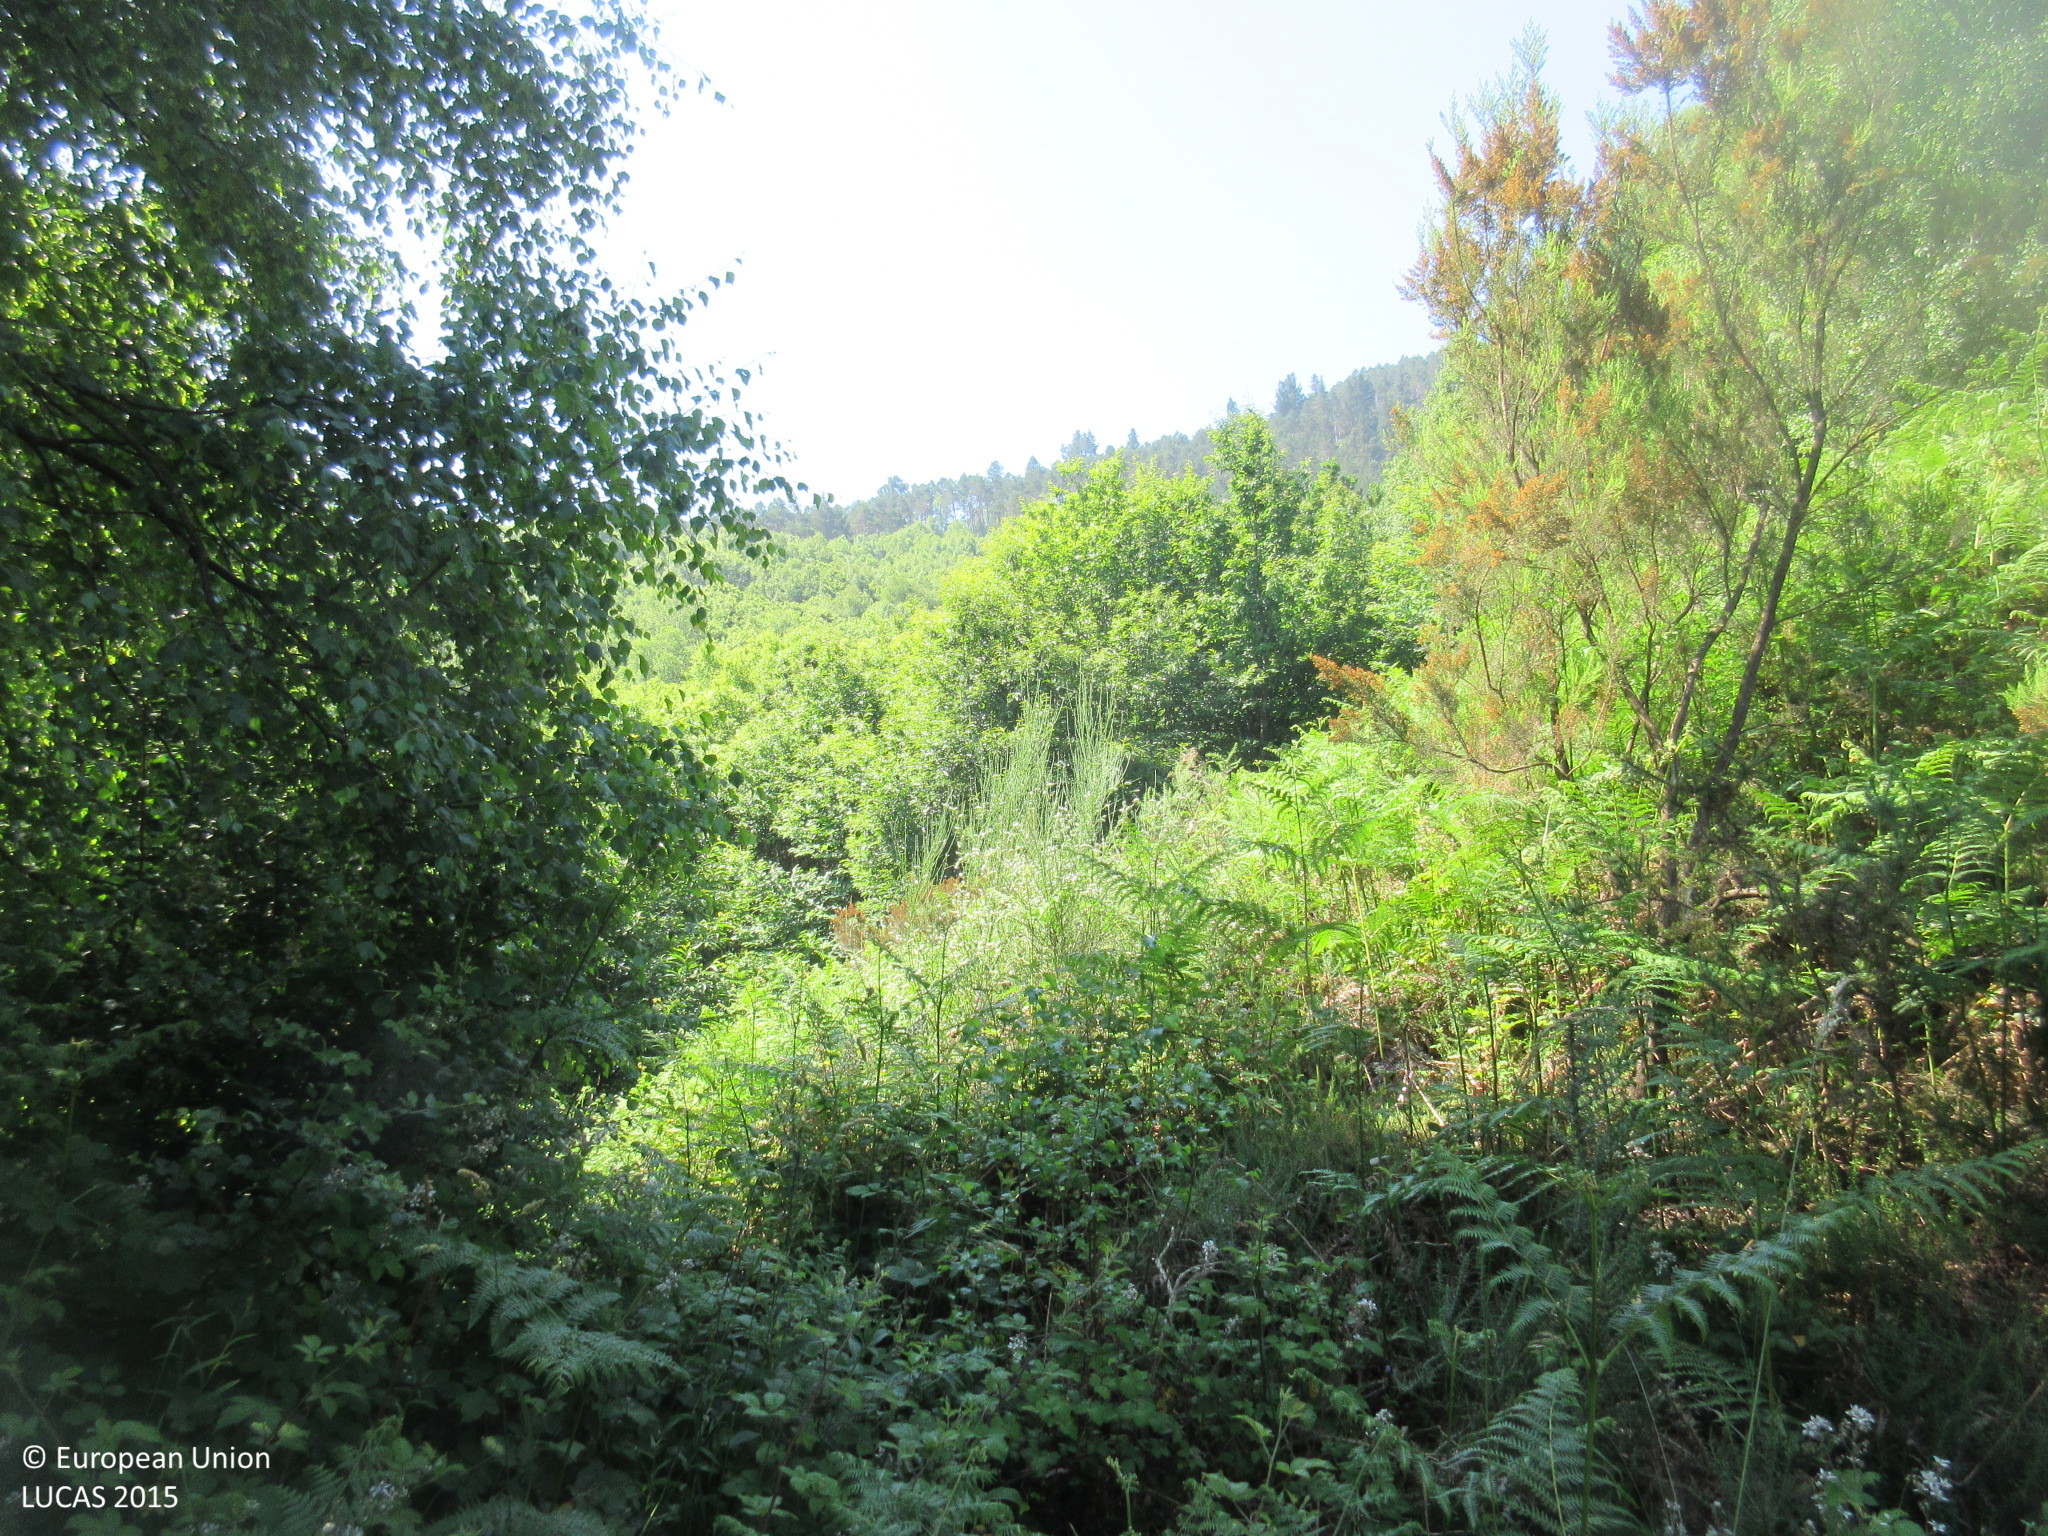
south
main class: Woodland
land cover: Broadleaved woodland
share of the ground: 50 - 75 %
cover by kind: broadleaved forest trees 60 %, herbaceous plants 30 %, shrubs 10 %
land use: Forestry
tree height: < 5 m
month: June
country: ES
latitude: 43.0536
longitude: -7.1696
